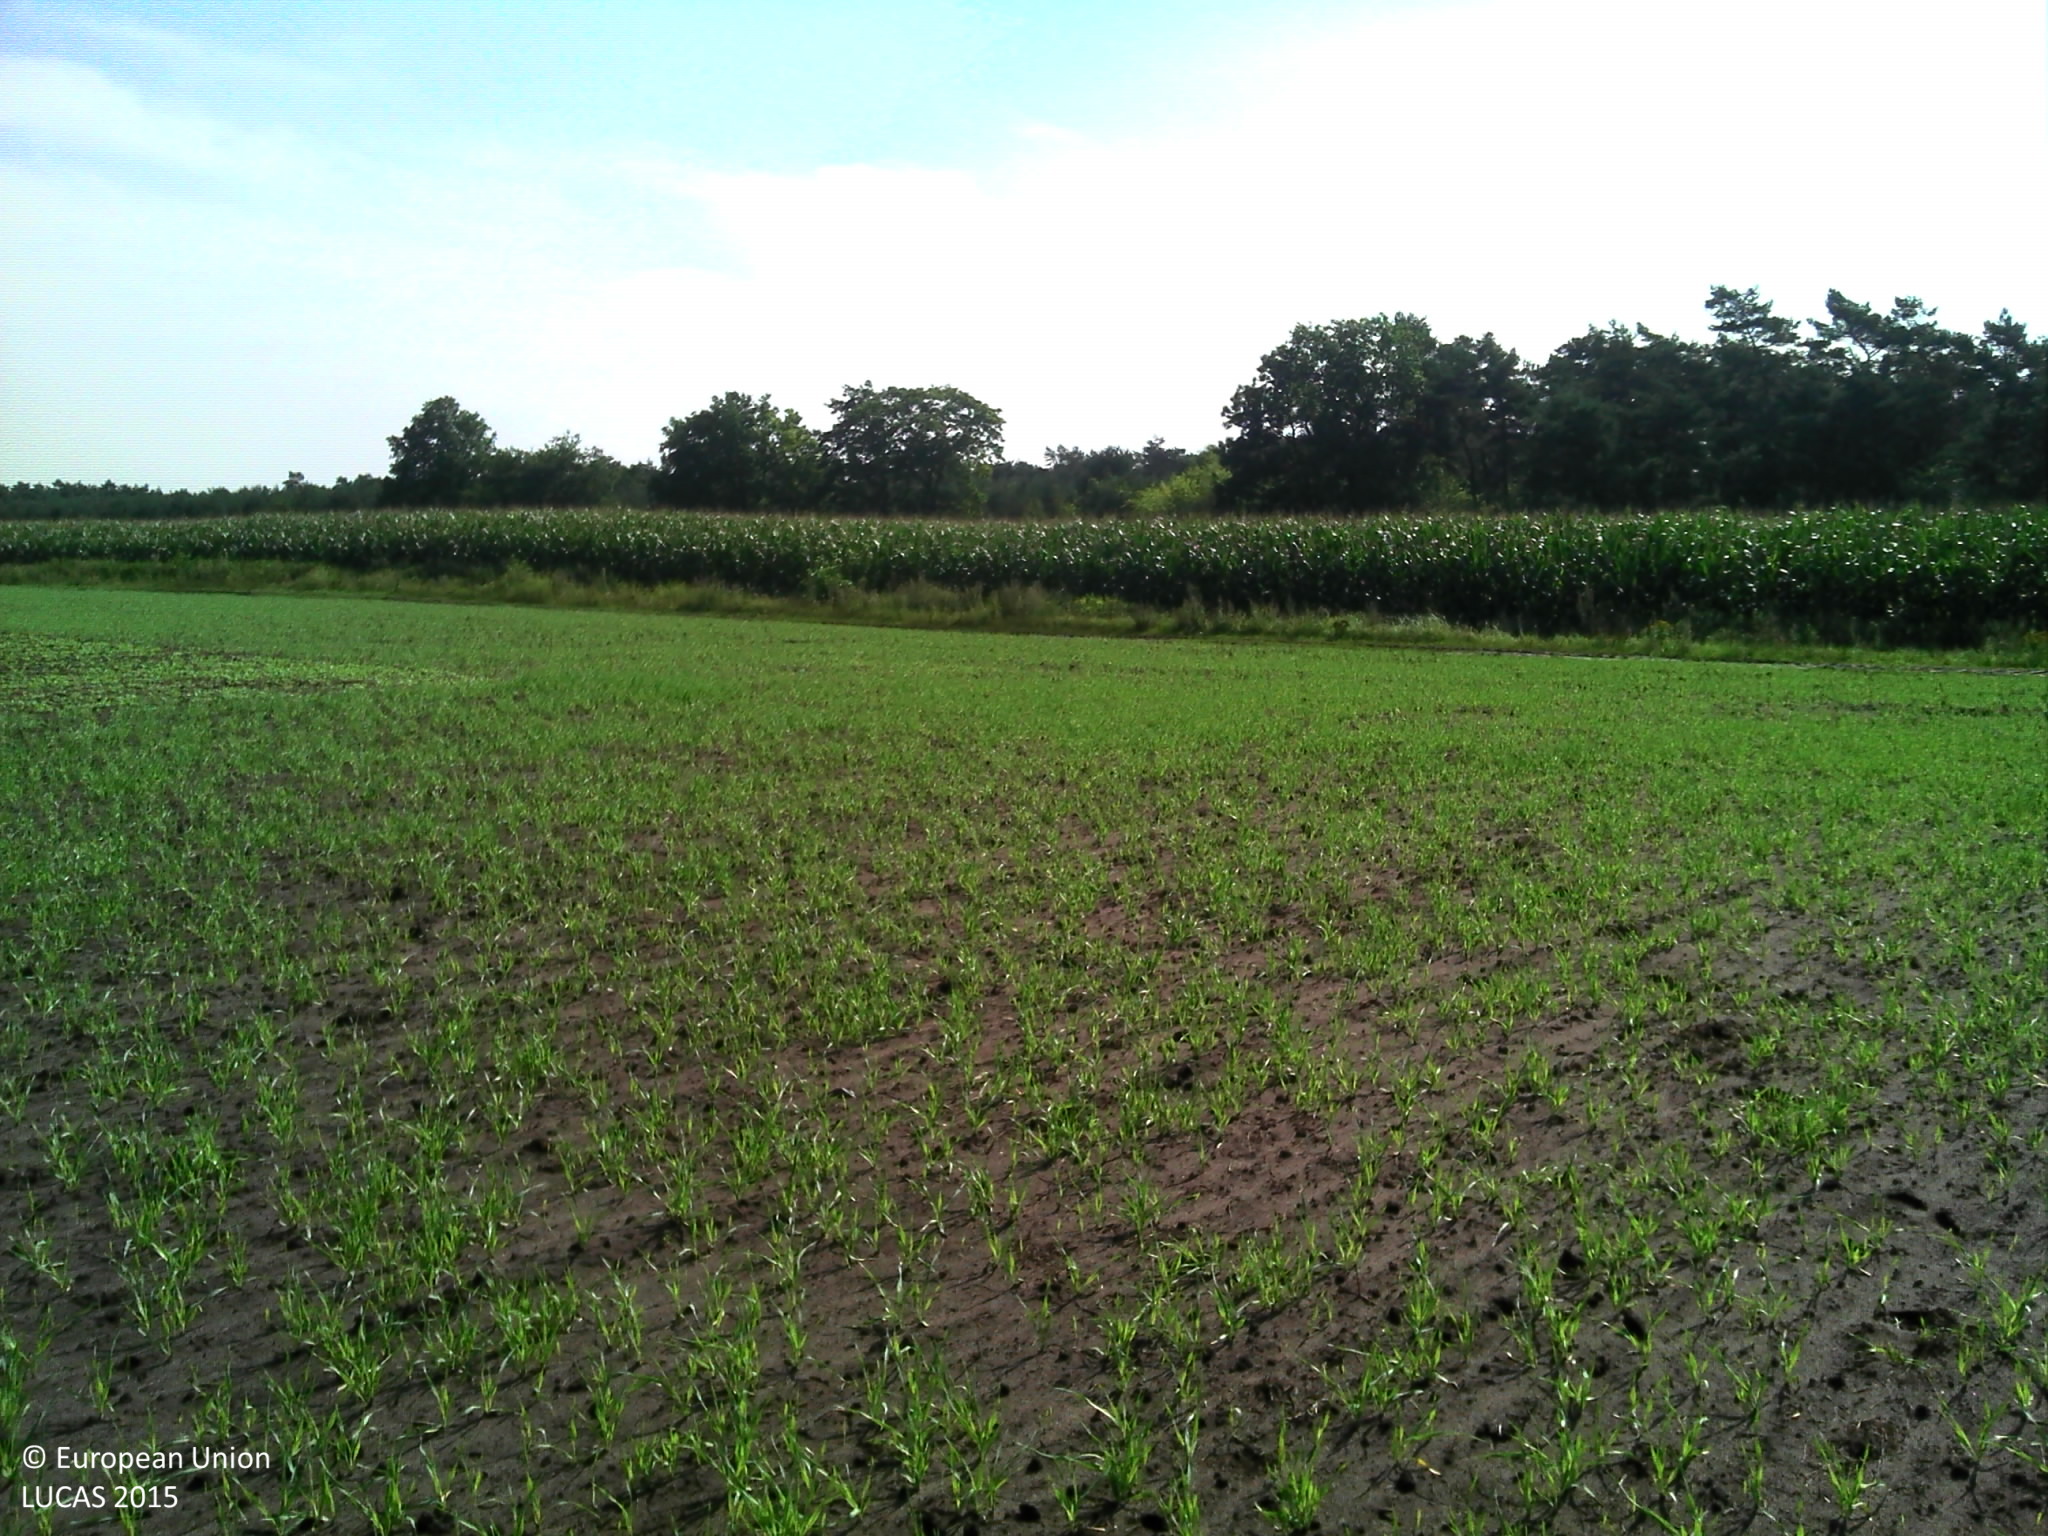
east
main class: Cropland
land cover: Common wheat
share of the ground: < 10 %
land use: Agriculture (excluding fallow land and kitchen gardens)
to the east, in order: Common wheat; Tracks; Grass margins; Maize; Grass margins; Fences; Grass margins; Tracks; Grass margins; Paved roads, cycling and walking lanes; Pine dominated coniferous woodland
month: August
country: BE
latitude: 51.2551
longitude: 5.2262
